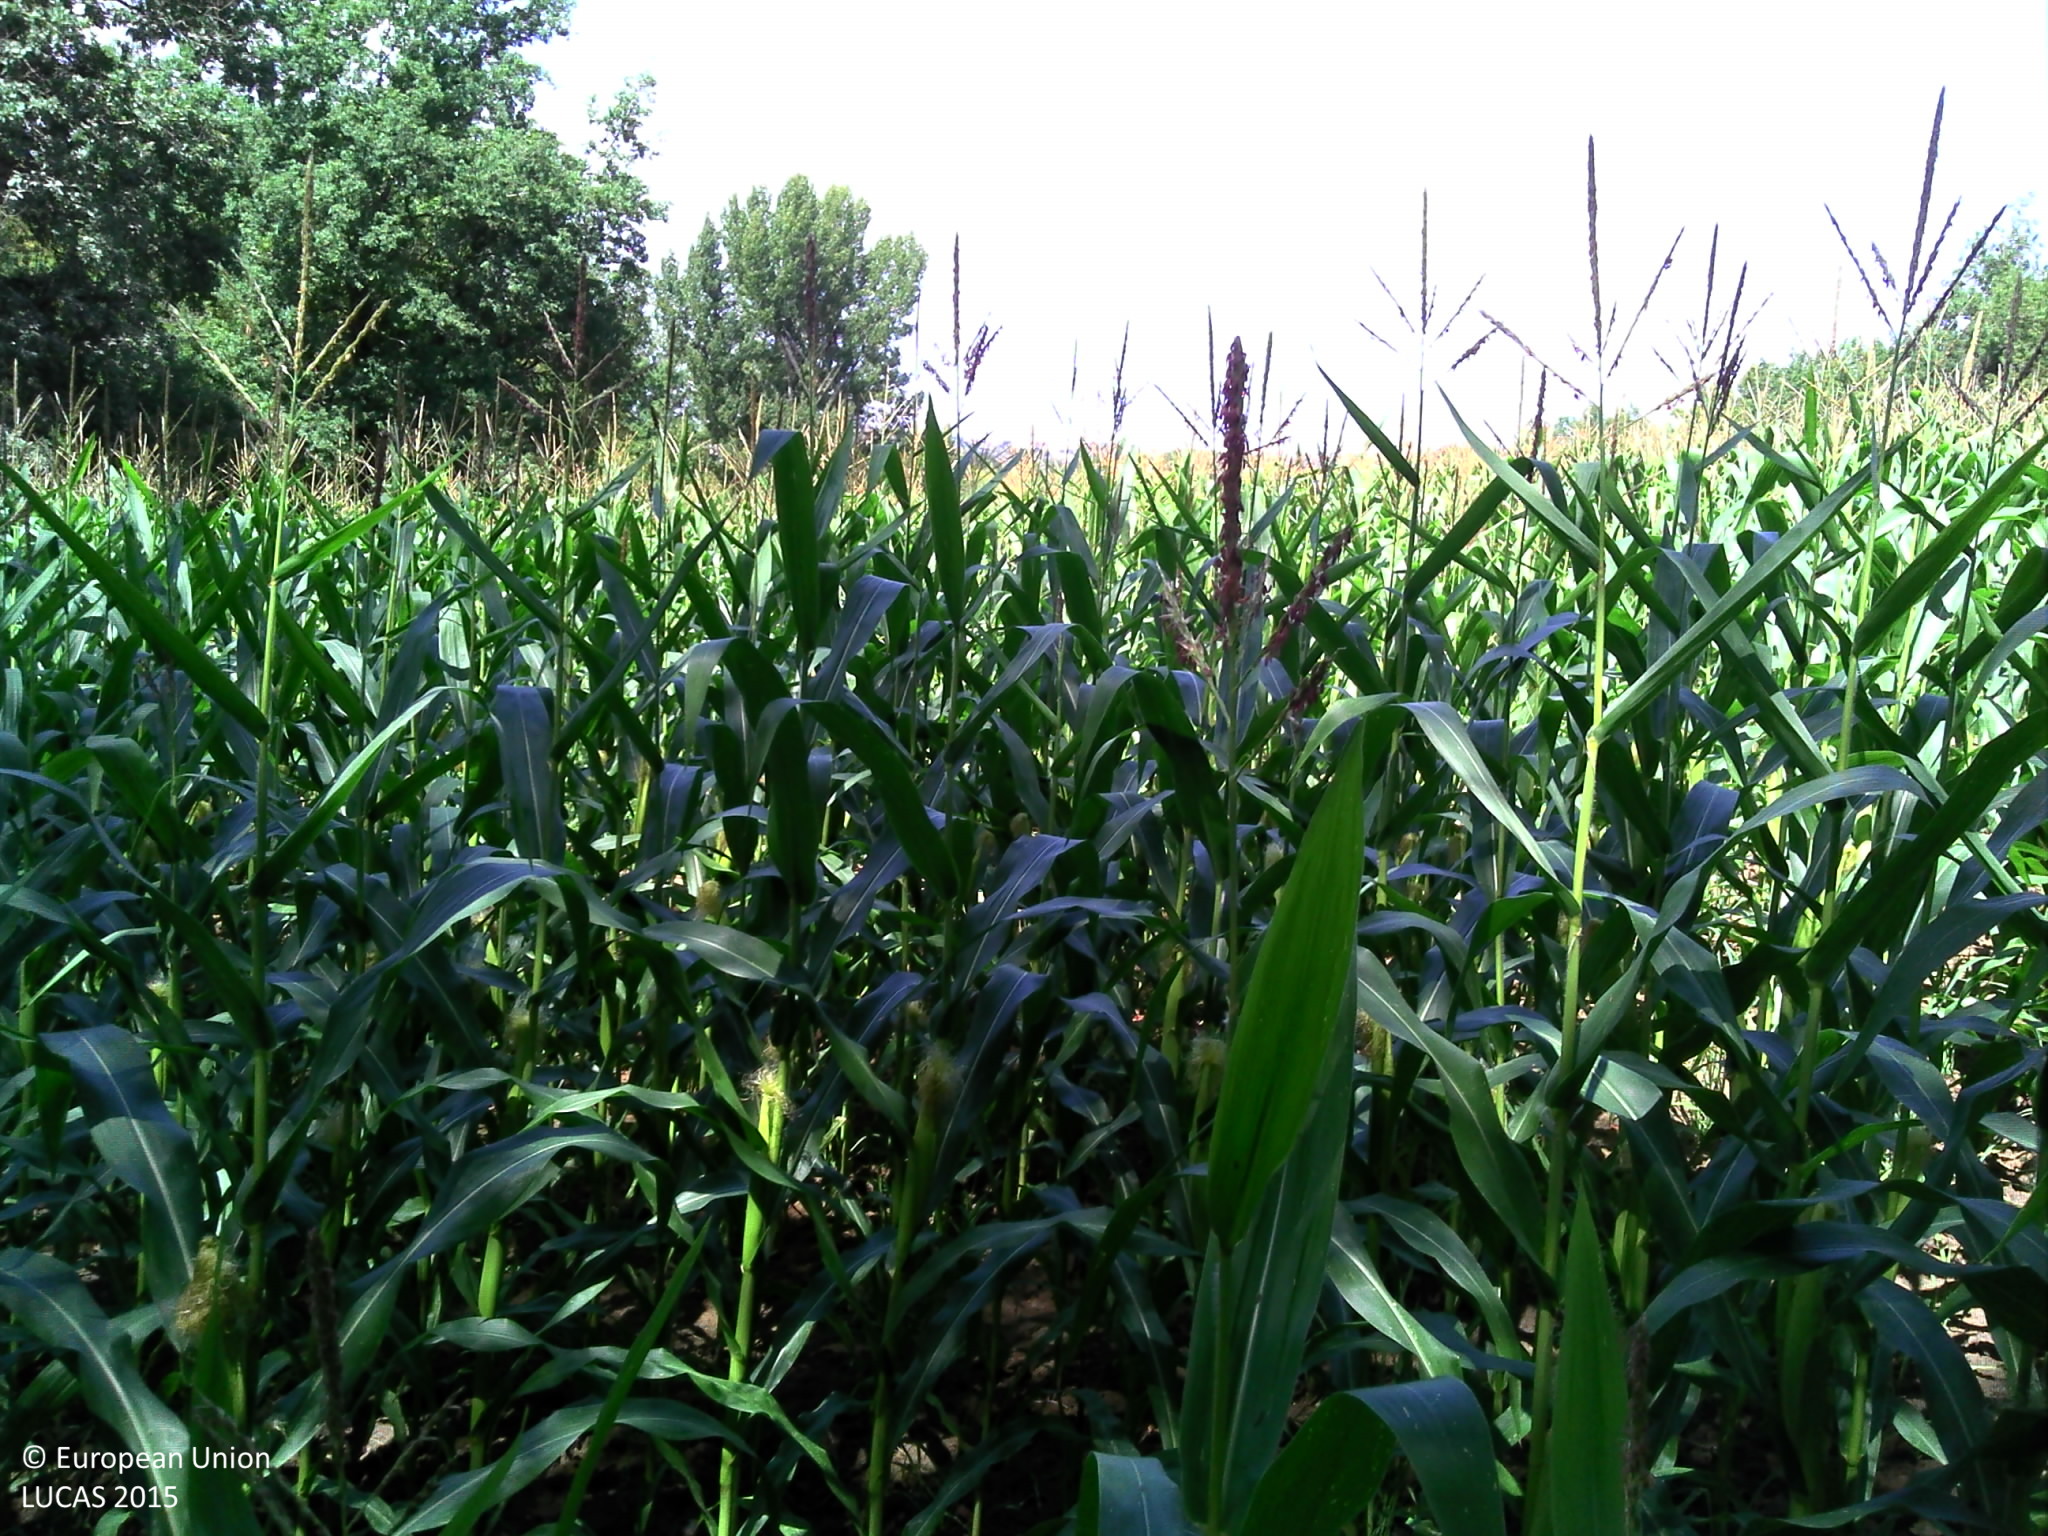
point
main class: Cropland
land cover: Maize
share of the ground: > 75 %
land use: Agriculture (excluding fallow land and kitchen gardens)
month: August
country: FR
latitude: 44.2189
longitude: 1.5006
